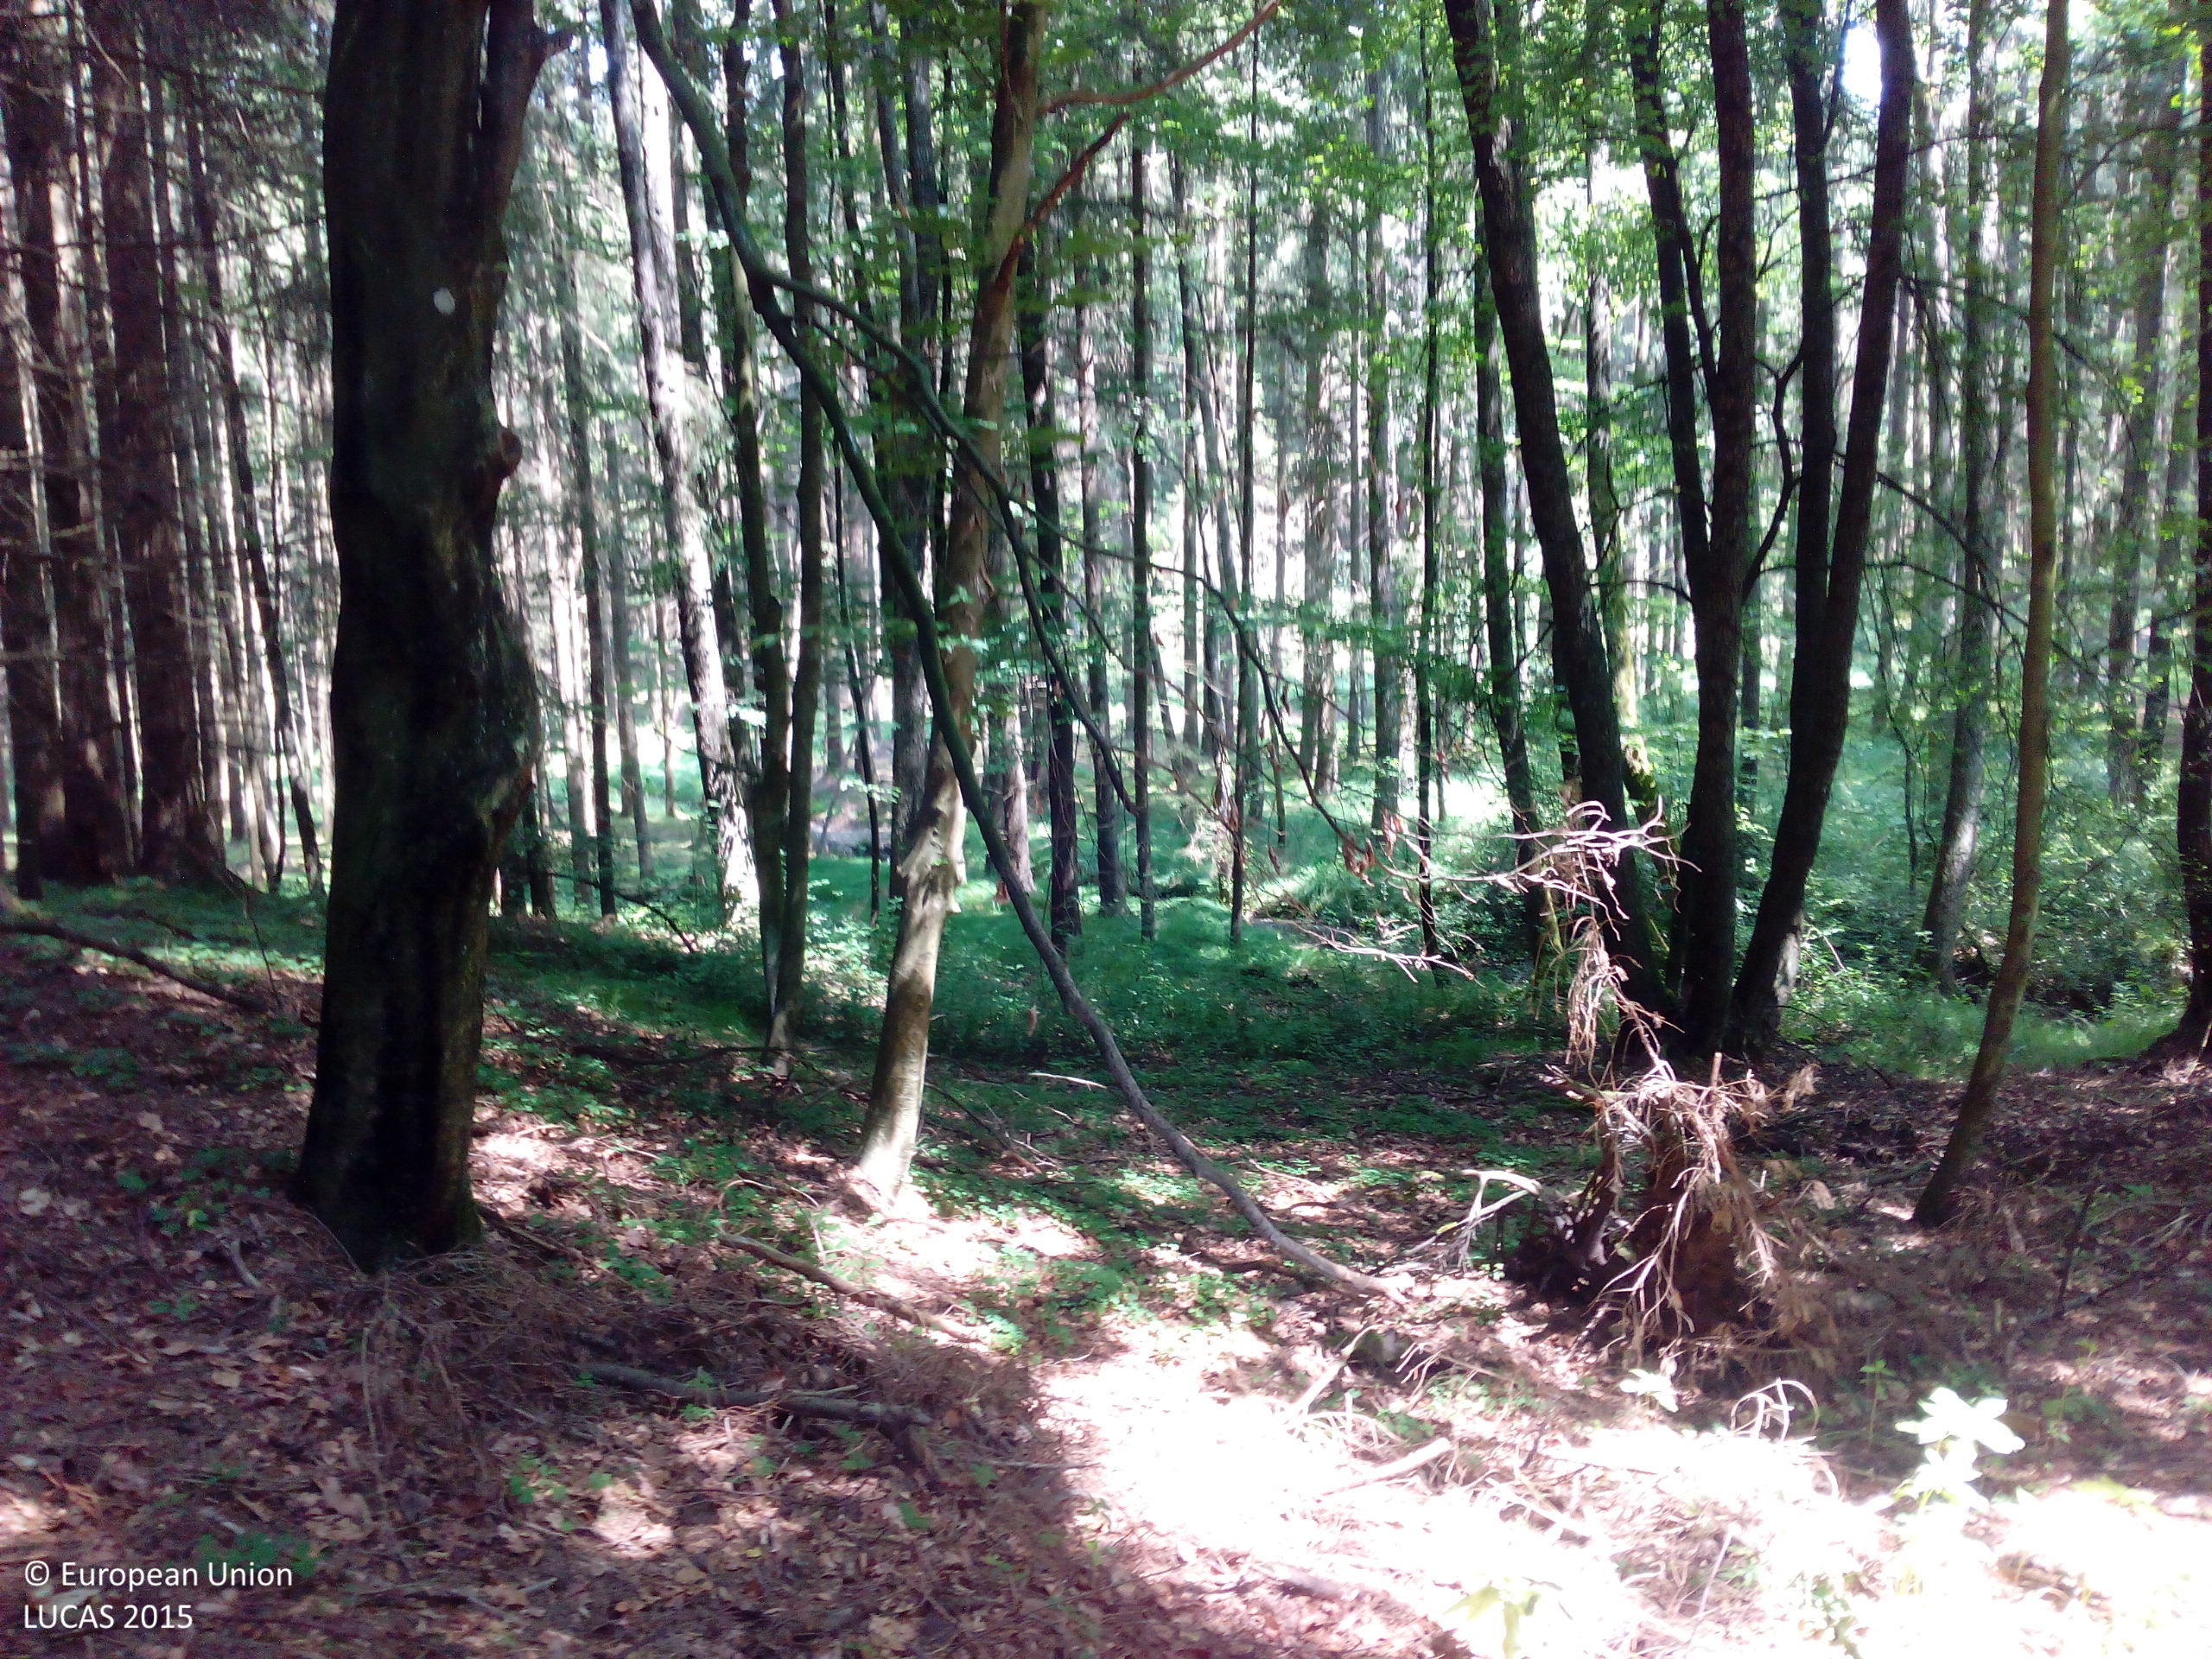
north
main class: Woodland
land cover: Spruce dominated mixed woodland
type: hemiboreal forest and nemoral coniferous forest and mixed broadleaved-coniferous forest
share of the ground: > 75 %
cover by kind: broadleaved forest trees 60 %, coniferous forest trees 25 %, unconsolidated bare surface 10 %, herbaceous plants 5 %
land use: Forestry
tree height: > 5 m
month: June
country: DE
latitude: 48.5086
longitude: 12.9366
